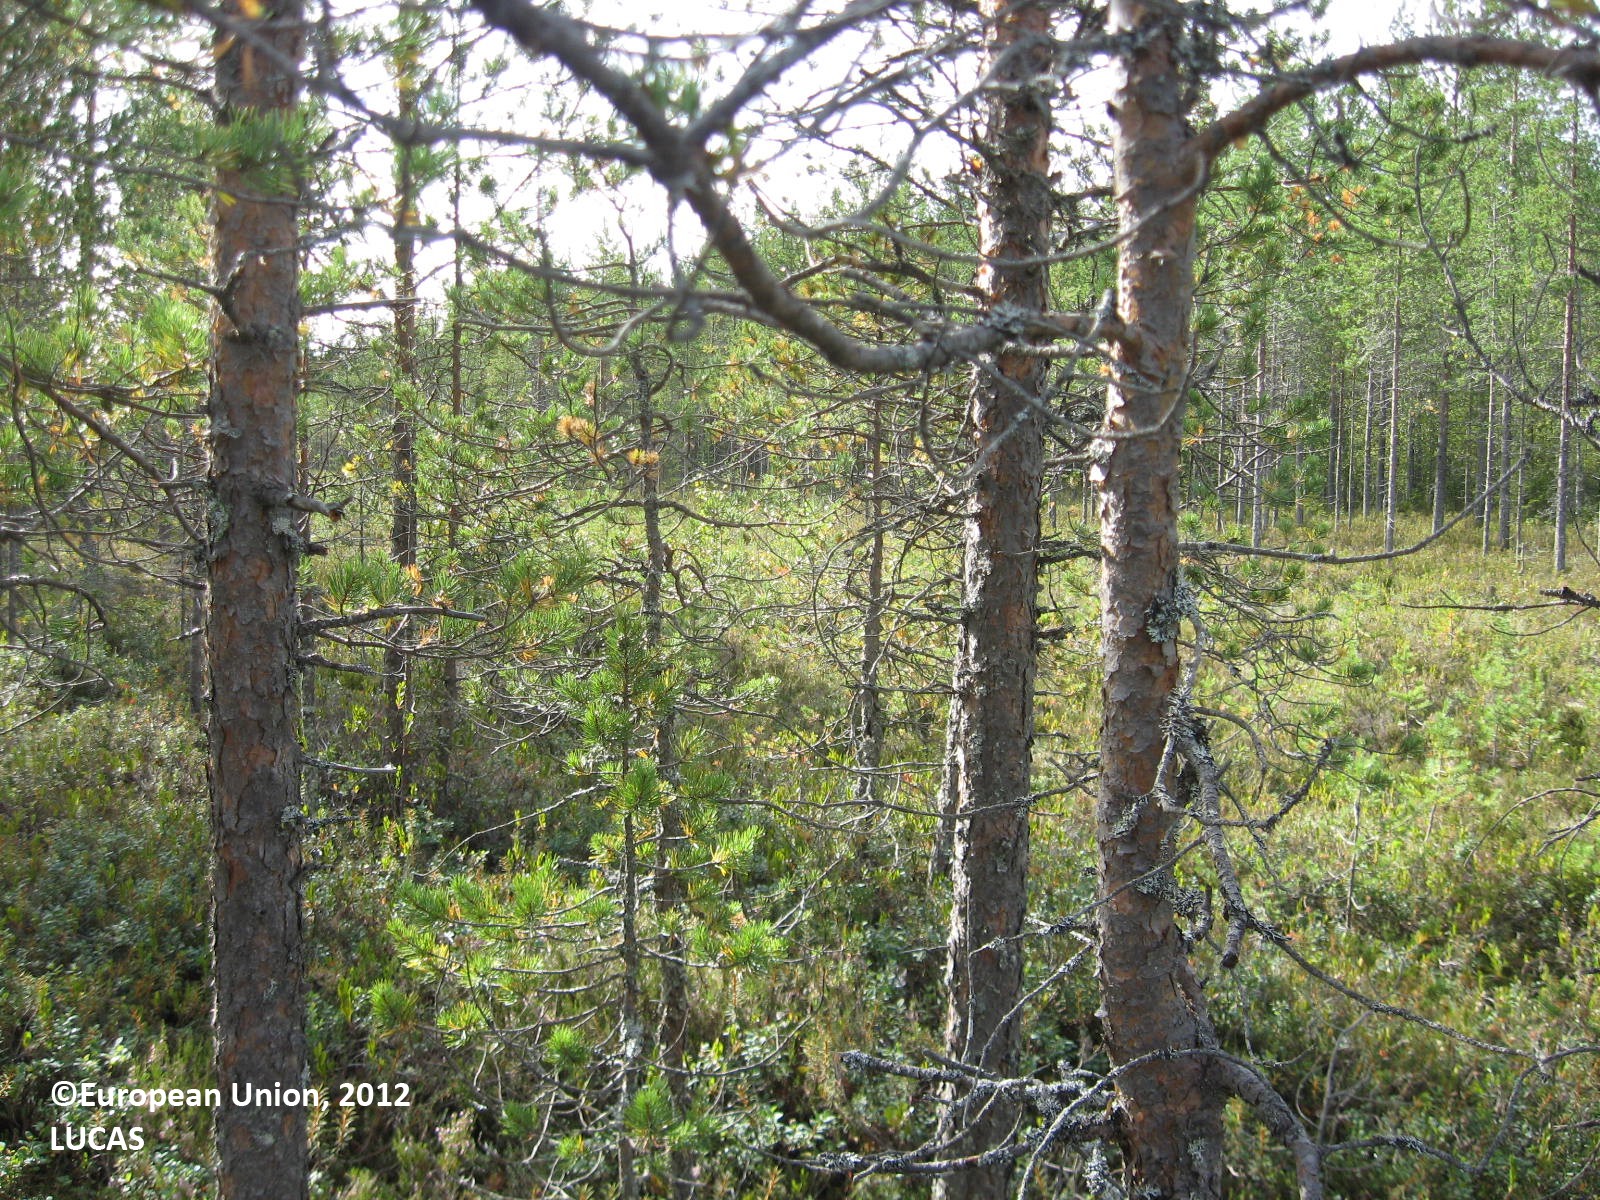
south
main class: Woodland
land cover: Pine dominated coniferous woodland
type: boreal forest
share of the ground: 25 - 50 %
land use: Forestry
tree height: > 5 m
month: August
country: FI
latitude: 63.5965
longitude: 29.5157
